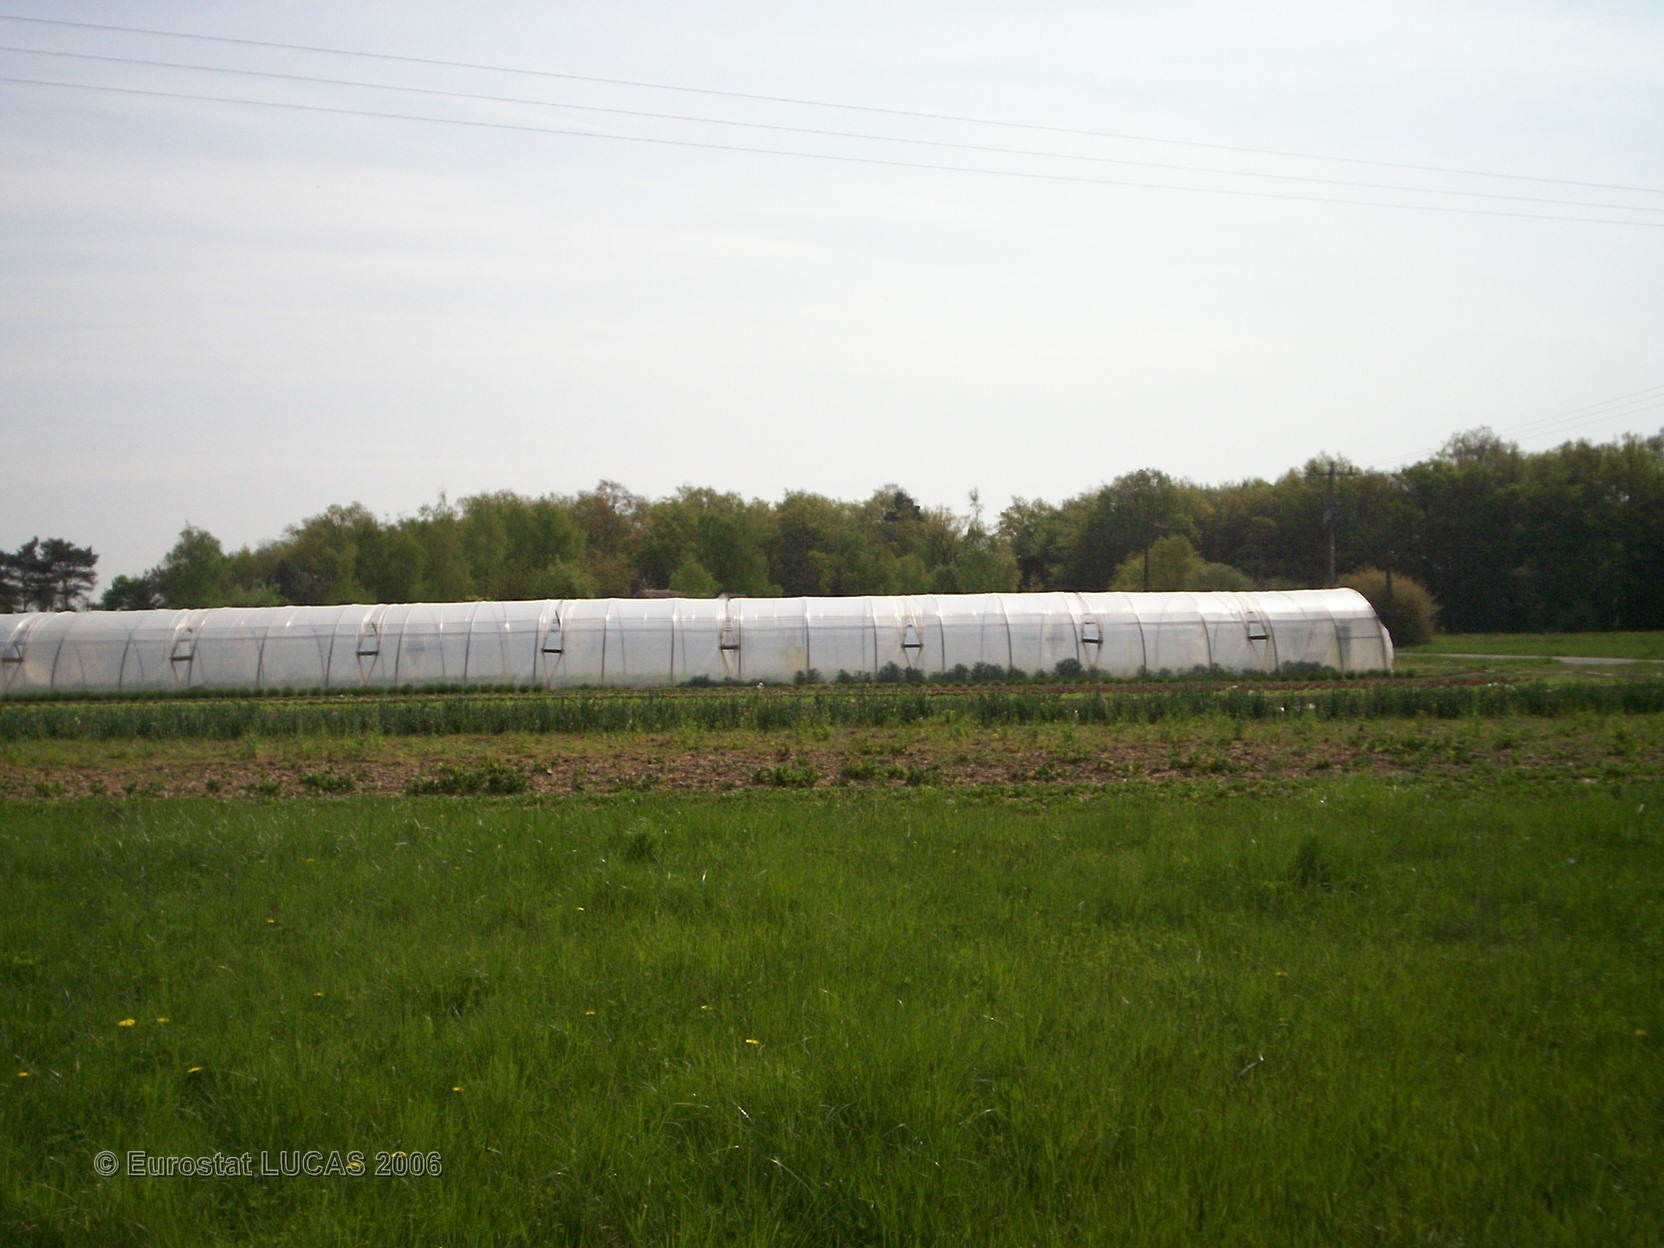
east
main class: Grassland
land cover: Grassland with sparse tree/shrub cover
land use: Agriculture (excluding fallow land and kitchen gardens)
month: May
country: FR
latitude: 48.0894
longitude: 2.9709
